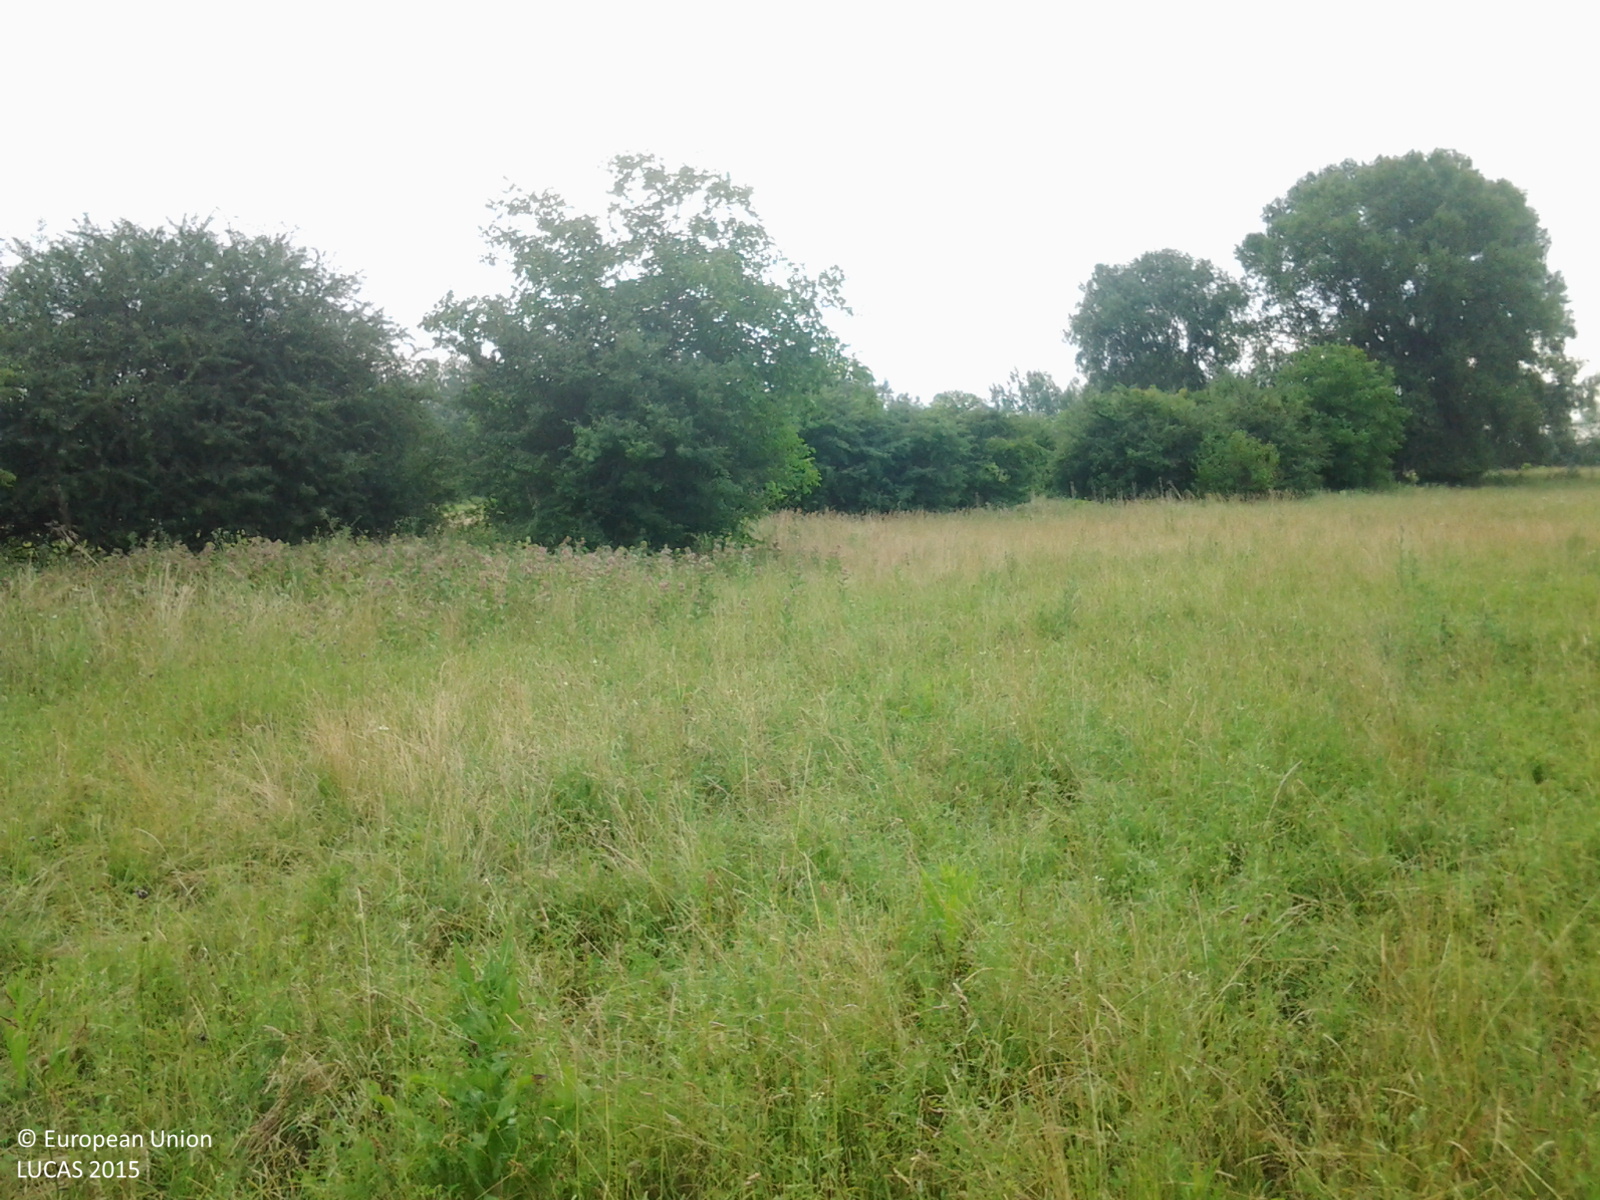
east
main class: Grassland
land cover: Grassland without tree/shrub cover
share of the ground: > 75 %
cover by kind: herbaceous plants 100 %
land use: Agriculture (excluding fallow land and kitchen gardens)
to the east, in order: Grassland without tree/shrub cover; Shrubland without tree cover; Grassland without tree/shrub cover; Abandoned hedges; Grassland without tree/shrub cover; Tracks; Abandoned hedges; Inland fresh running water; Abandoned hedges; Grassland without tree/shrub cover
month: June
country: HU
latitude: 46.4819
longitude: 19.1720
